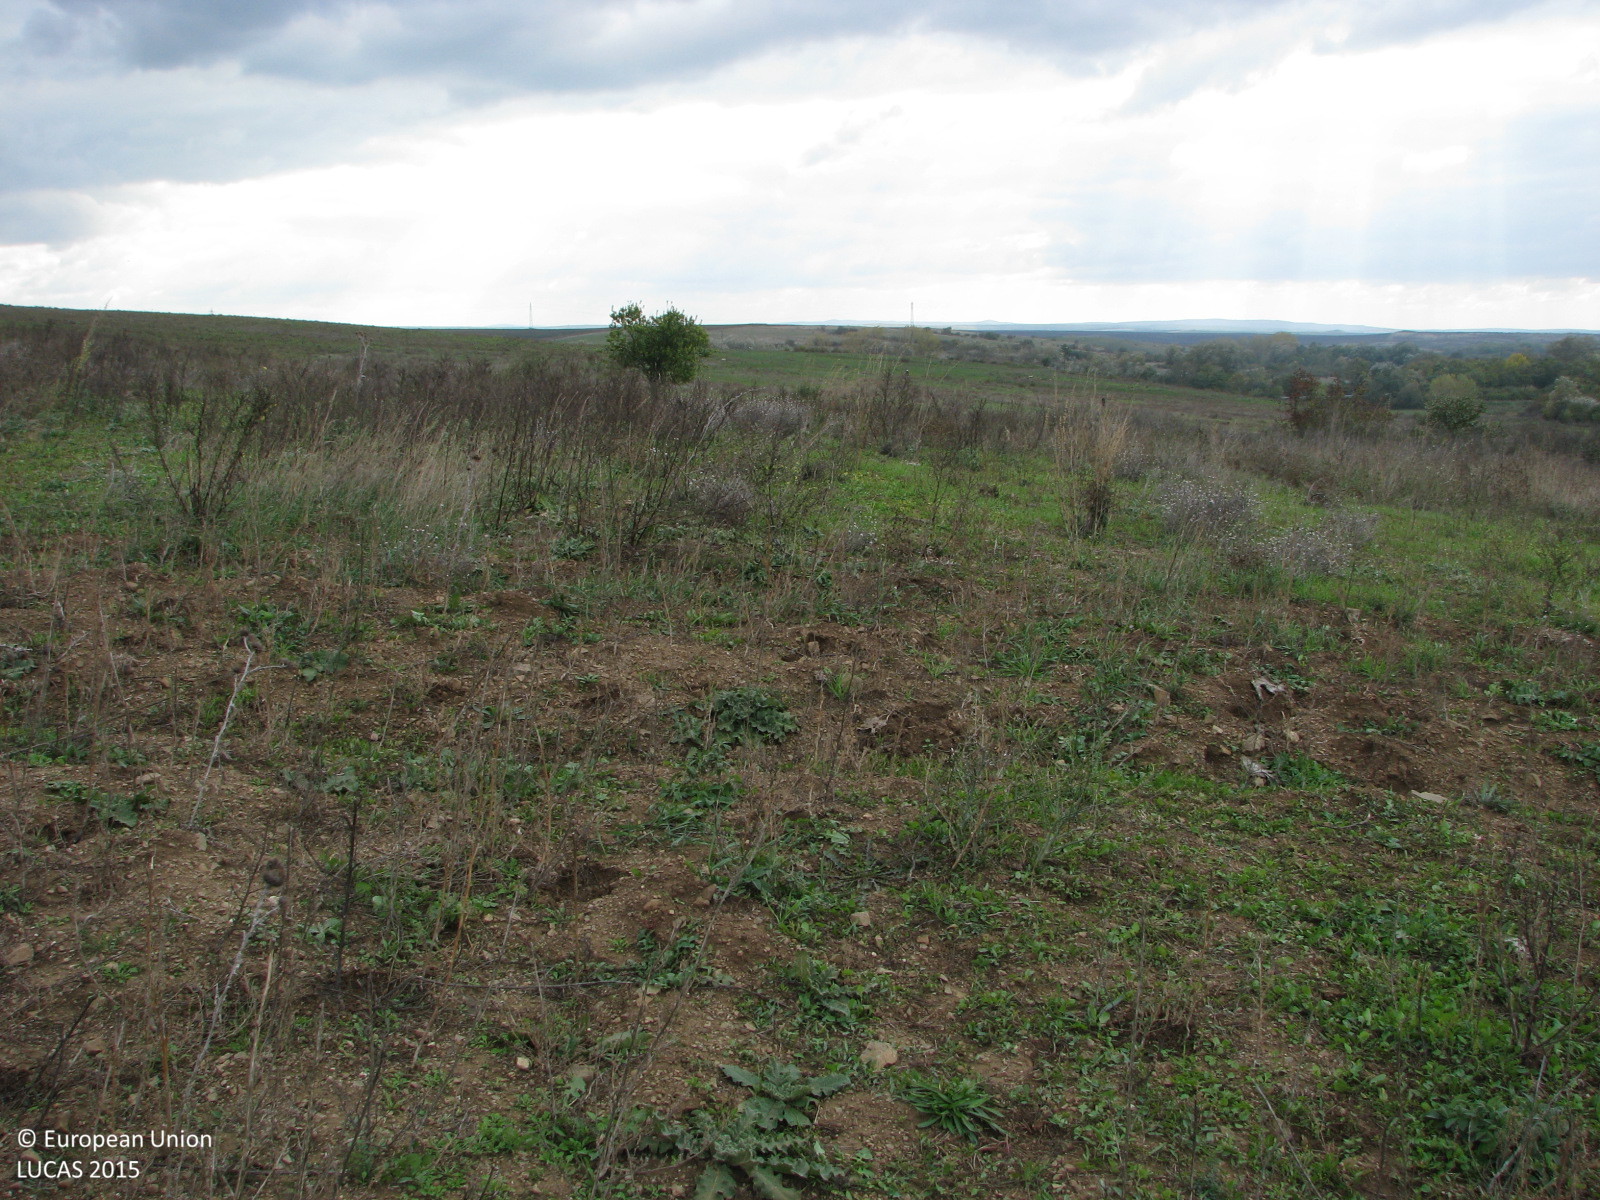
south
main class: Grassland
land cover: Spontaneously vegetated surfaces
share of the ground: 50 - 75 %
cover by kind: herbaceous plants 60 %, unconsolidated bare surface 40 %
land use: Fallow land
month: October
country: BG
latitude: 42.2089
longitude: 26.7243
